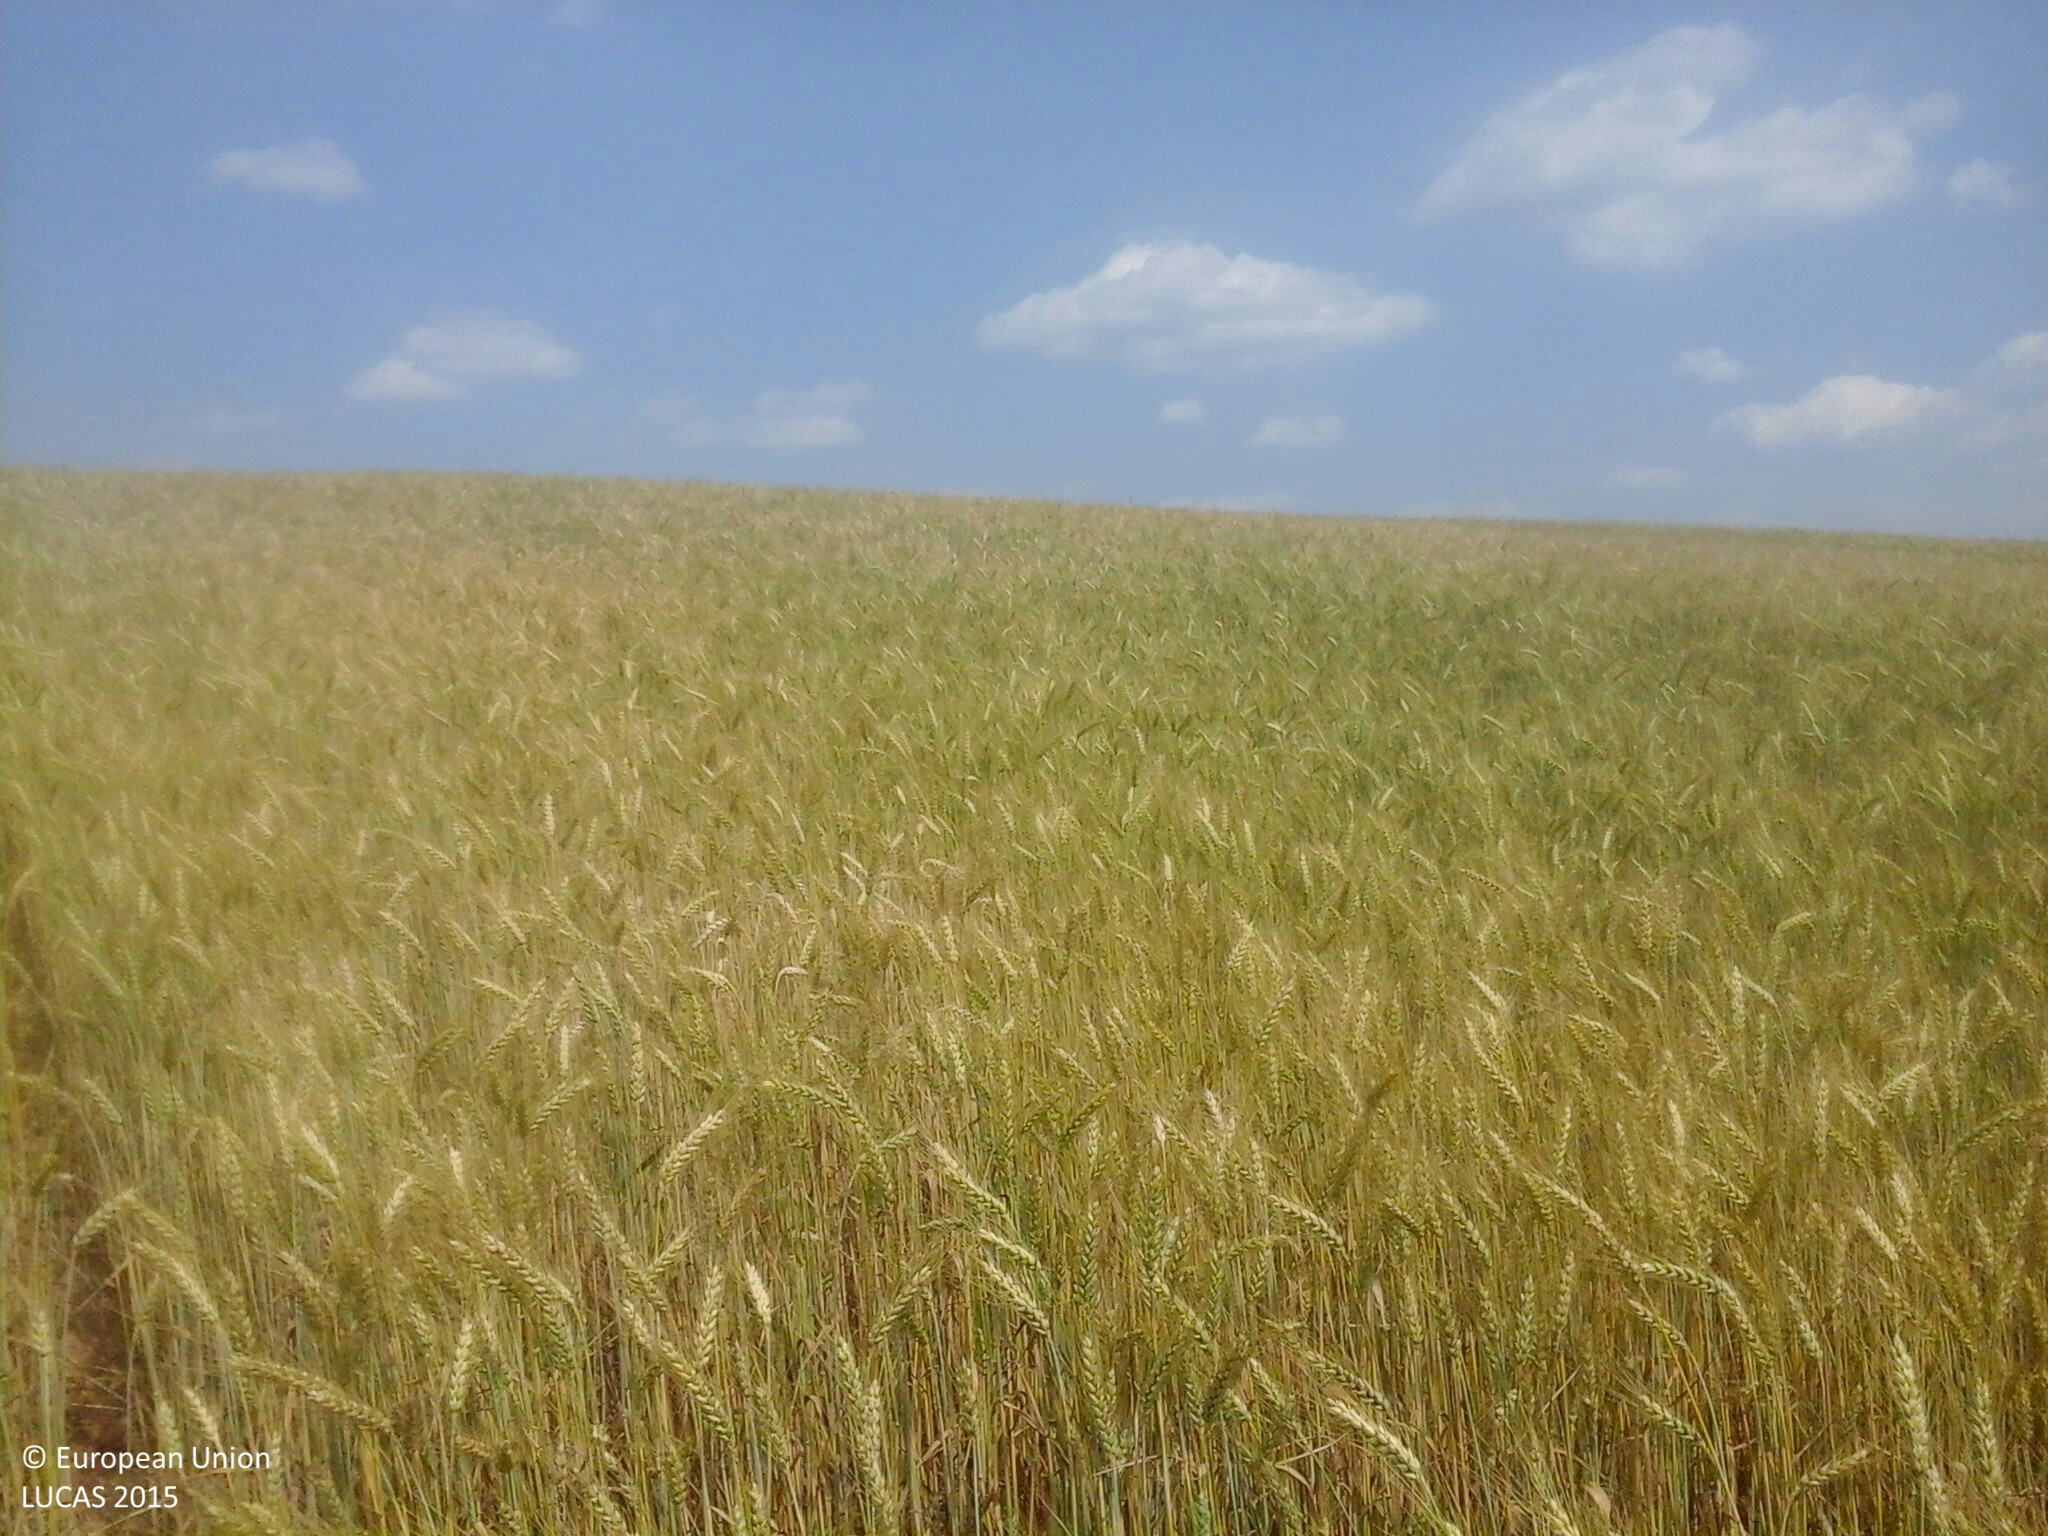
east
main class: Cropland
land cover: Common wheat
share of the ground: > 75 %
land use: Agriculture (excluding fallow land and kitchen gardens)
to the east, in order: Common wheat
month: July
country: HU
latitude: 47.3141
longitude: 17.8008
